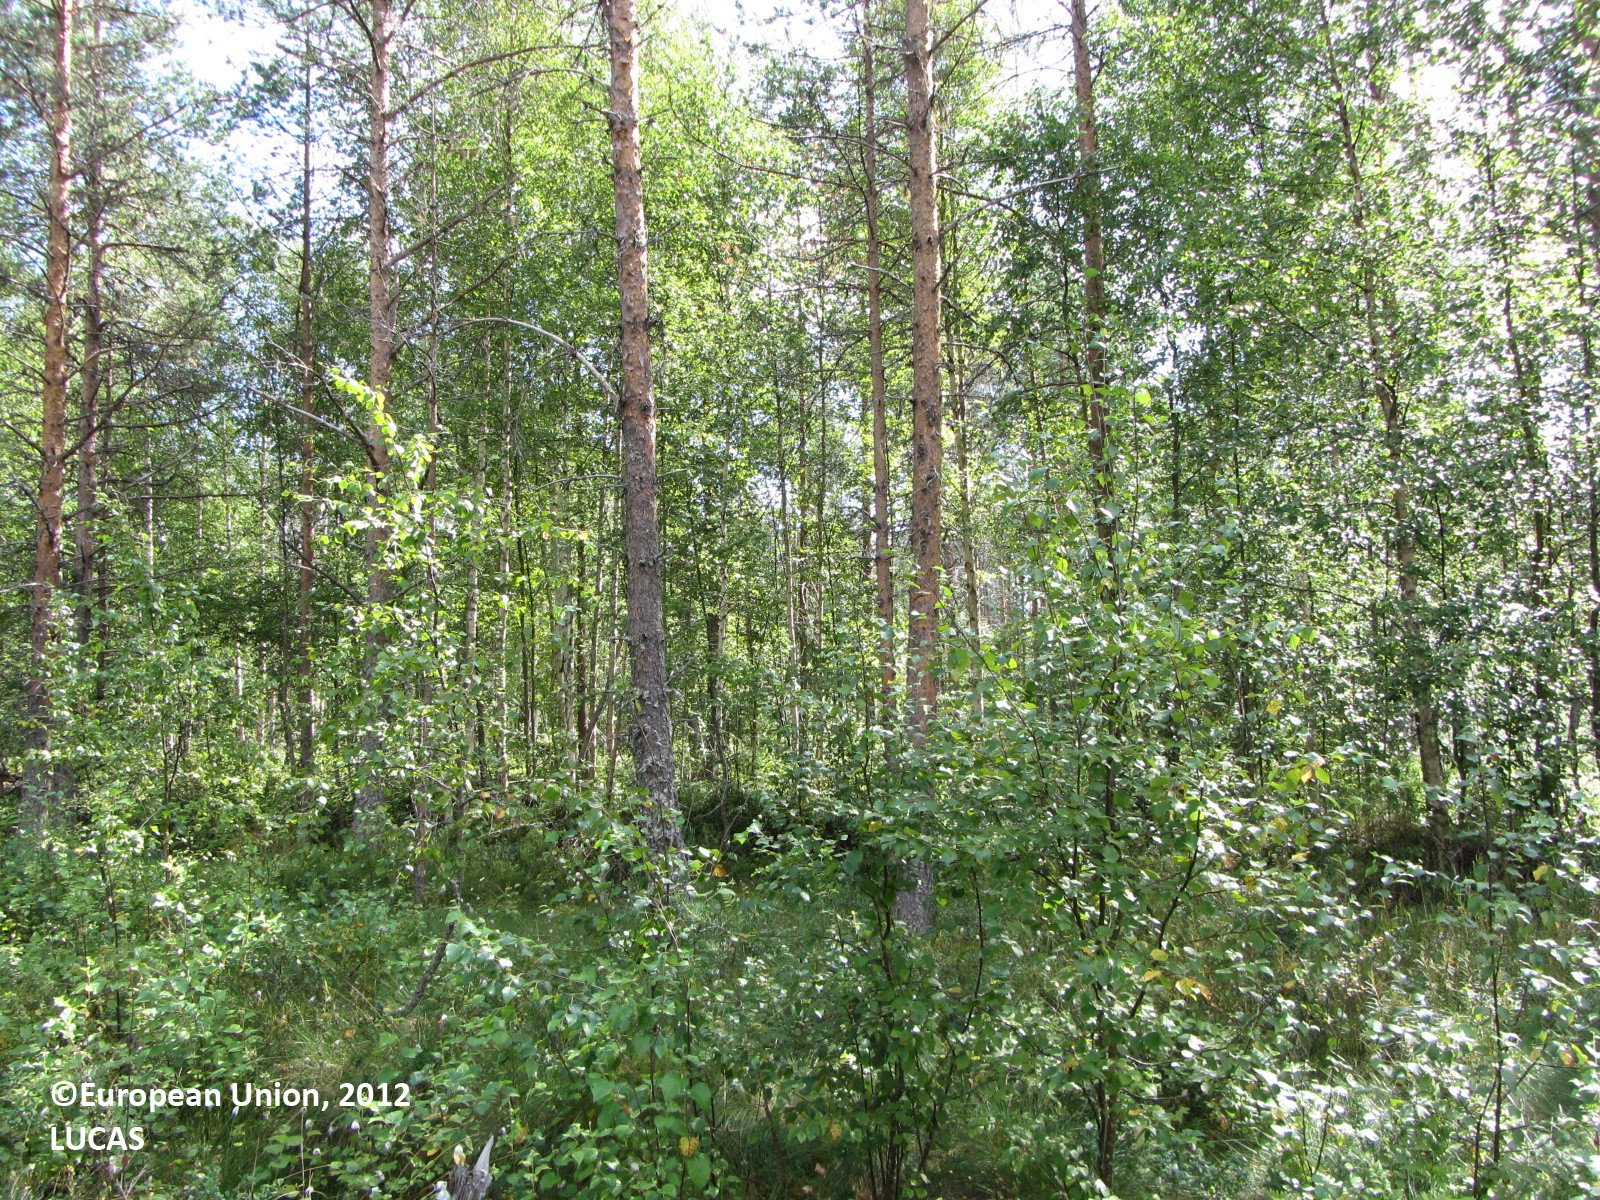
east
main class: Woodland
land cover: Pine dominated mixed woodland
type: boreal forest
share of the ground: 50 - 75 %
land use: Forestry
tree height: > 5 m
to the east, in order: Pine dominated mixed woodland; Ditches and canals; Pine dominated mixed woodland; Shrubland with sparse tree cover; Pine dominated coniferous woodland; Ditches and canals; Pine dominated coniferous woodland; Ditches and canals; Pine dominated coniferous woodland; Ditches and canals; Broadleaved woodland; Pine dominated coniferous woodland; Ditches and canals; Pine dominated coniferous woodland; Ditches and canals; Pine dominated coniferous woodland
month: July
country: FI
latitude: 63.6445
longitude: 24.5968
